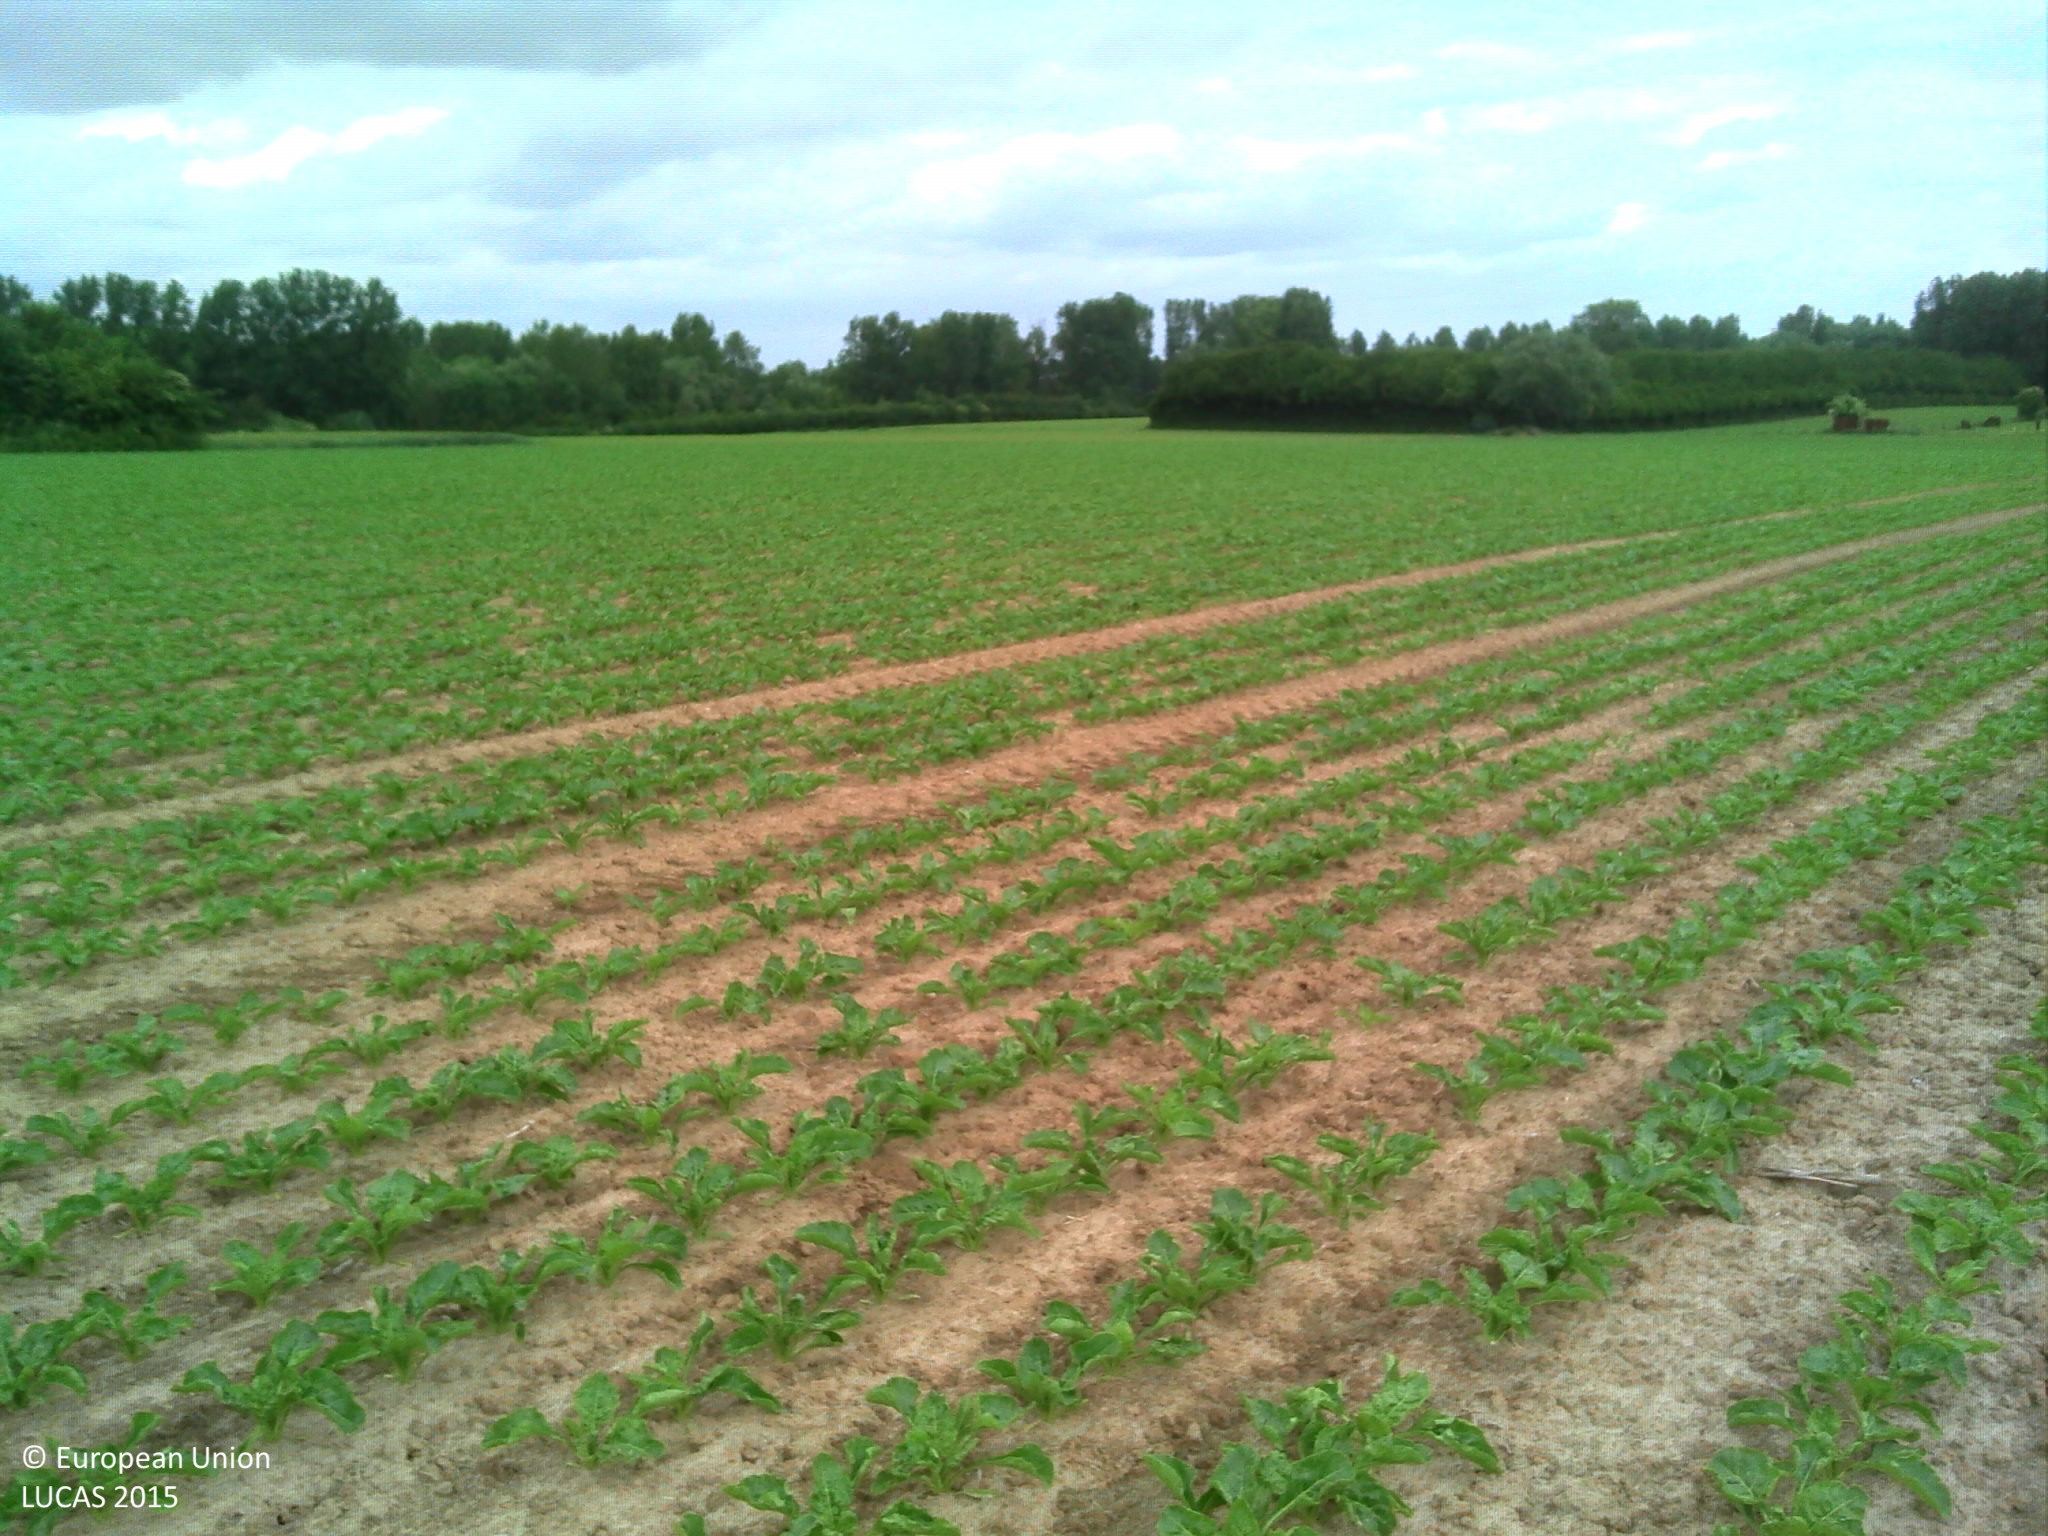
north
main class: Cropland
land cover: Sugar beet
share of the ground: 50 - 75 %
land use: Agriculture (excluding fallow land and kitchen gardens)
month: June
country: BE
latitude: 50.8564
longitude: 4.0136
